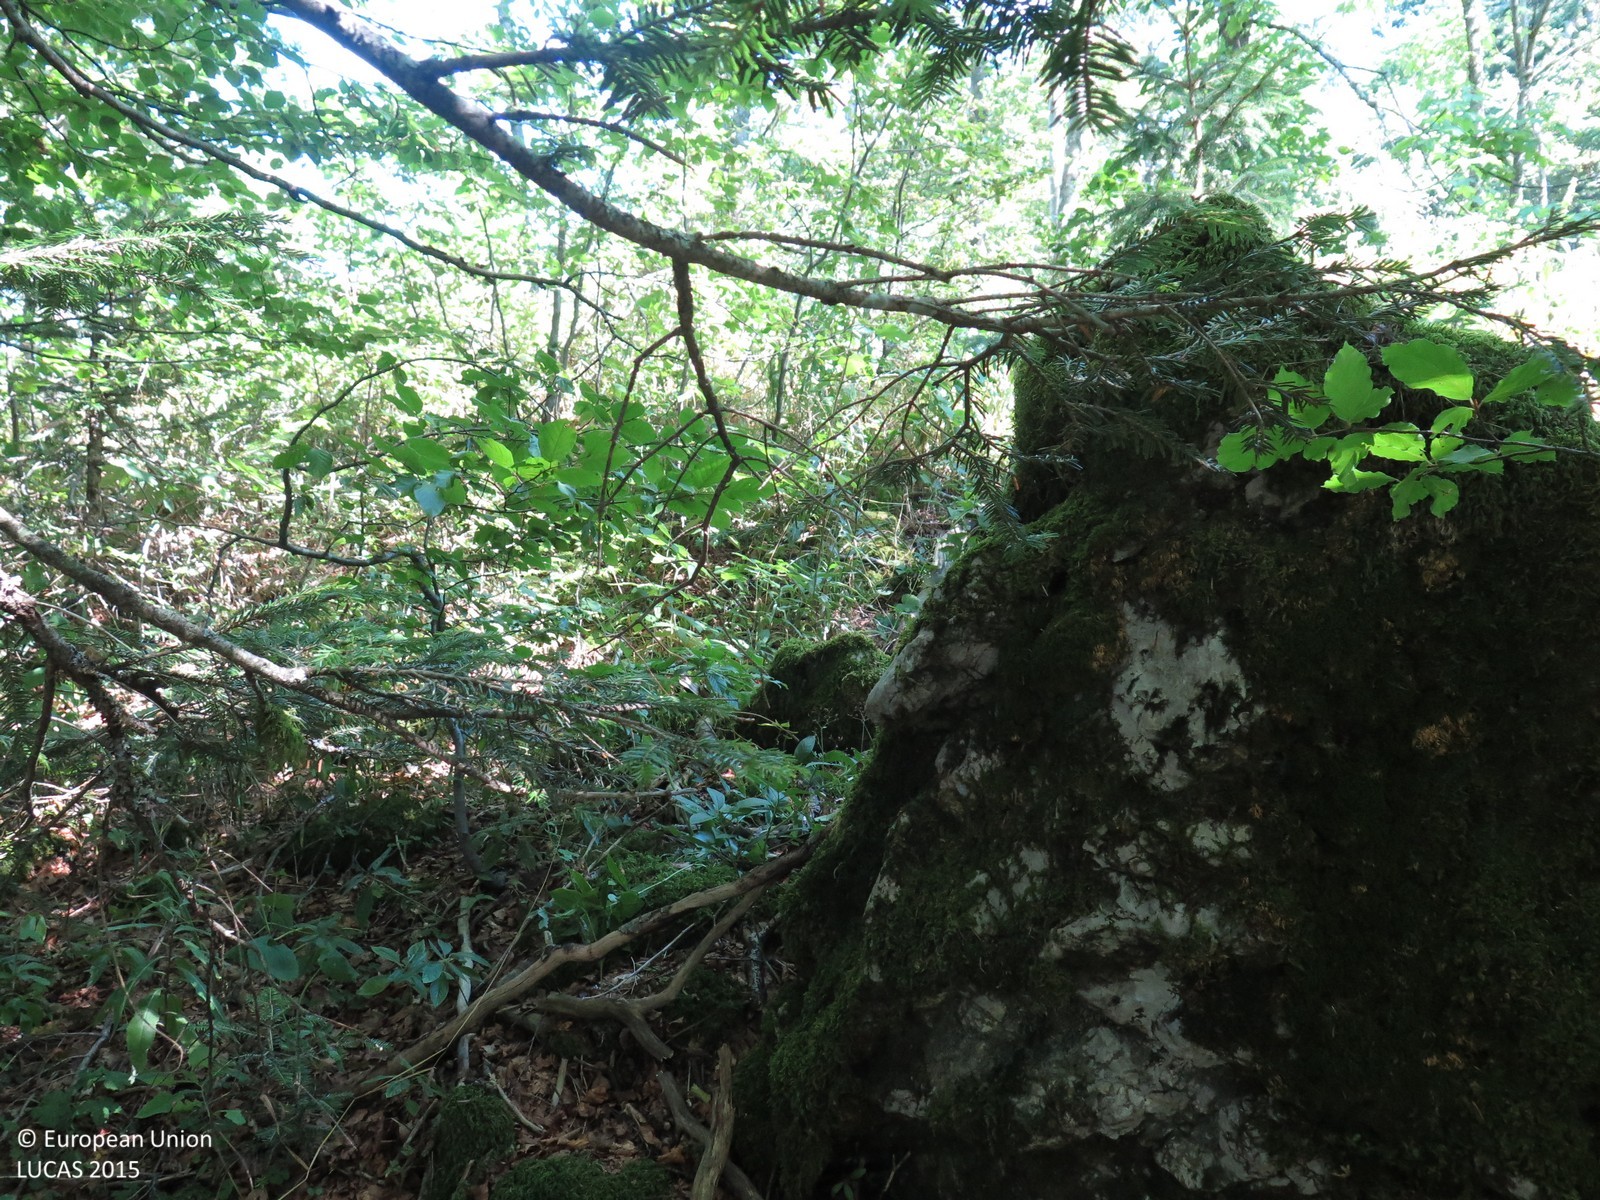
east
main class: Woodland
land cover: Other mixed woodland
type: mountainous beech forest
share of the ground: > 75 %
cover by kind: coniferous forest trees 75 %, broadleaved forest trees 25 %
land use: Forestry
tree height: > 5 m
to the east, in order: Other mixed woodland; Shrubland with sparse tree cover; Broadleaved woodland; Grass margins; Tracks; Grass margins; Other mixed woodland
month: August
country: HR
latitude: 45.2486
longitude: 14.8493
